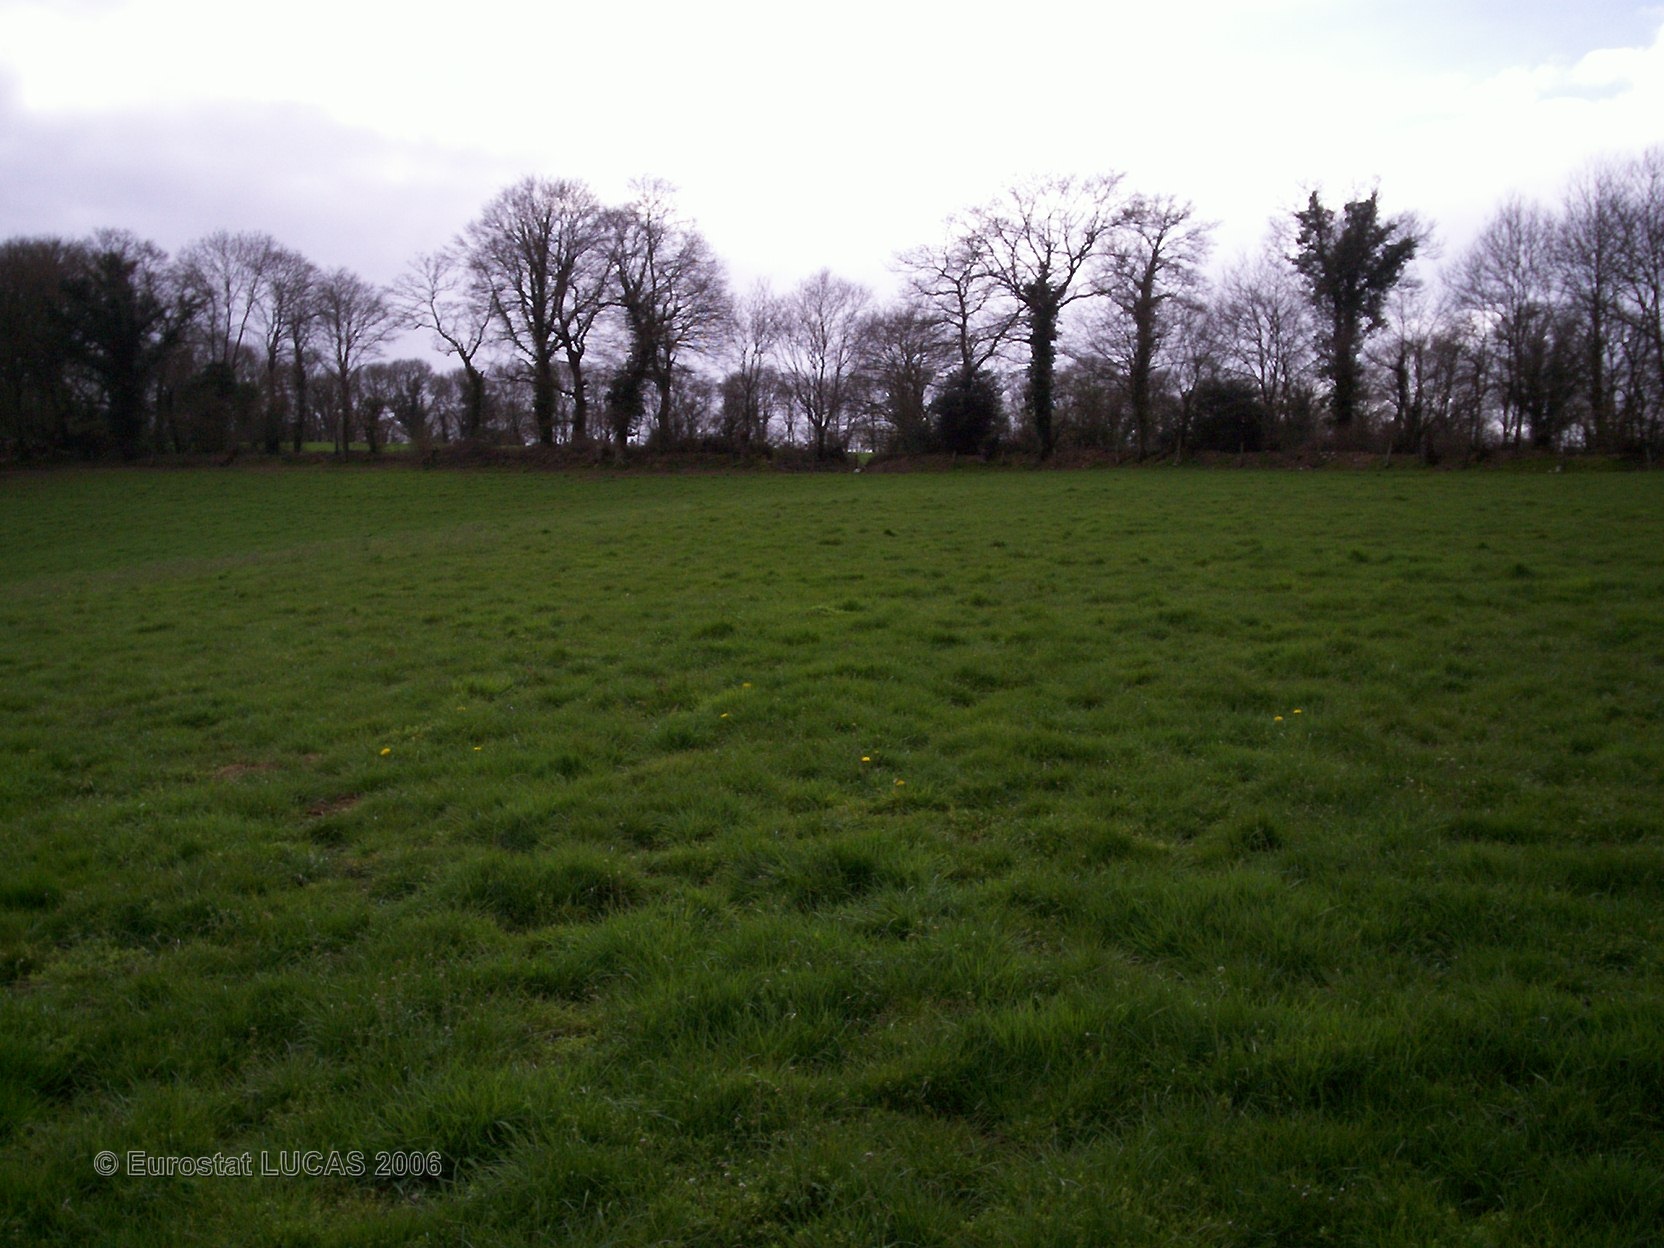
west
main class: Grassland
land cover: Grassland without tree/shrub cover
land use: Agriculture (excluding fallow land and kitchen gardens)
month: April
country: FR
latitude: 48.2079
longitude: -3.6584
